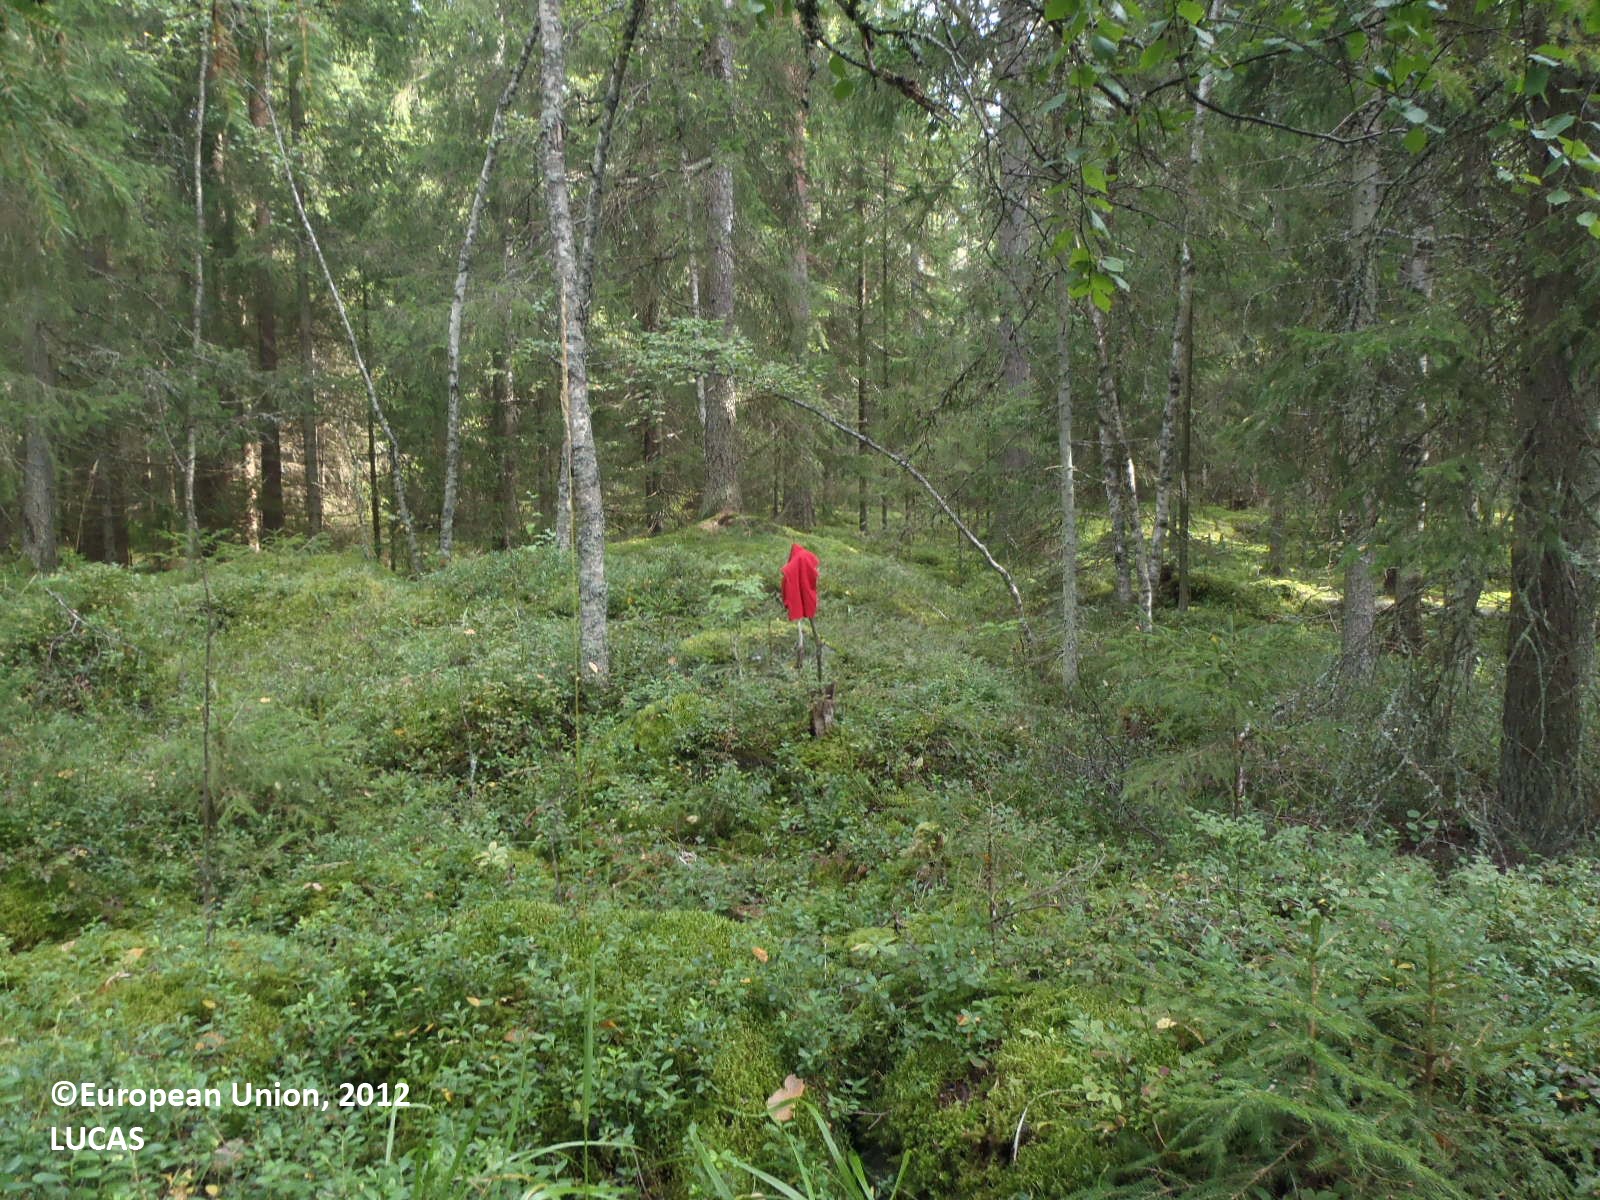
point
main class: Woodland
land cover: Spruce dominated coniferous woodland
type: boreal forest
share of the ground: 50 - 75 %
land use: Forestry
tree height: > 5 m
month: August
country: FI
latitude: 60.8093
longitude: 22.2884
